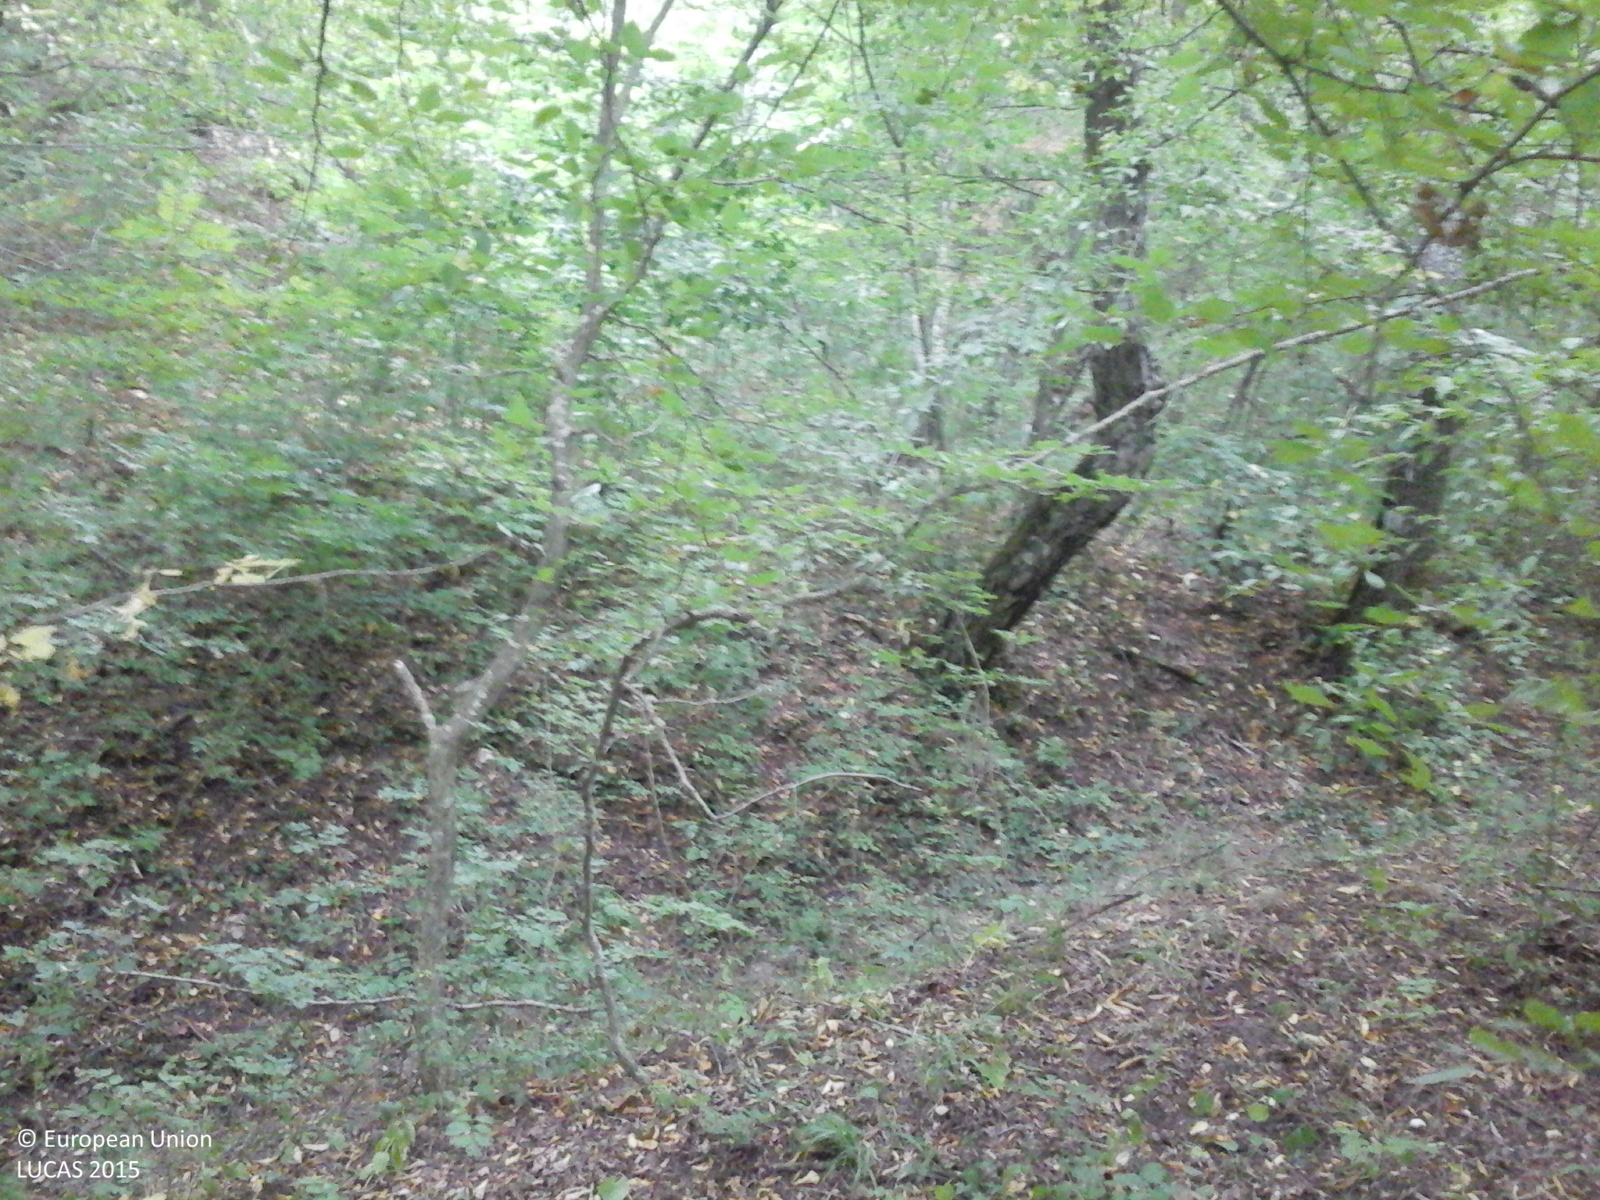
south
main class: Woodland
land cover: Broadleaved woodland
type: beech forest
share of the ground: > 75 %
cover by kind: broadleaved forest trees 100 %
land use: Forestry
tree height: > 5 m
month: July
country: RO
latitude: 44.8676
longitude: 28.5969
